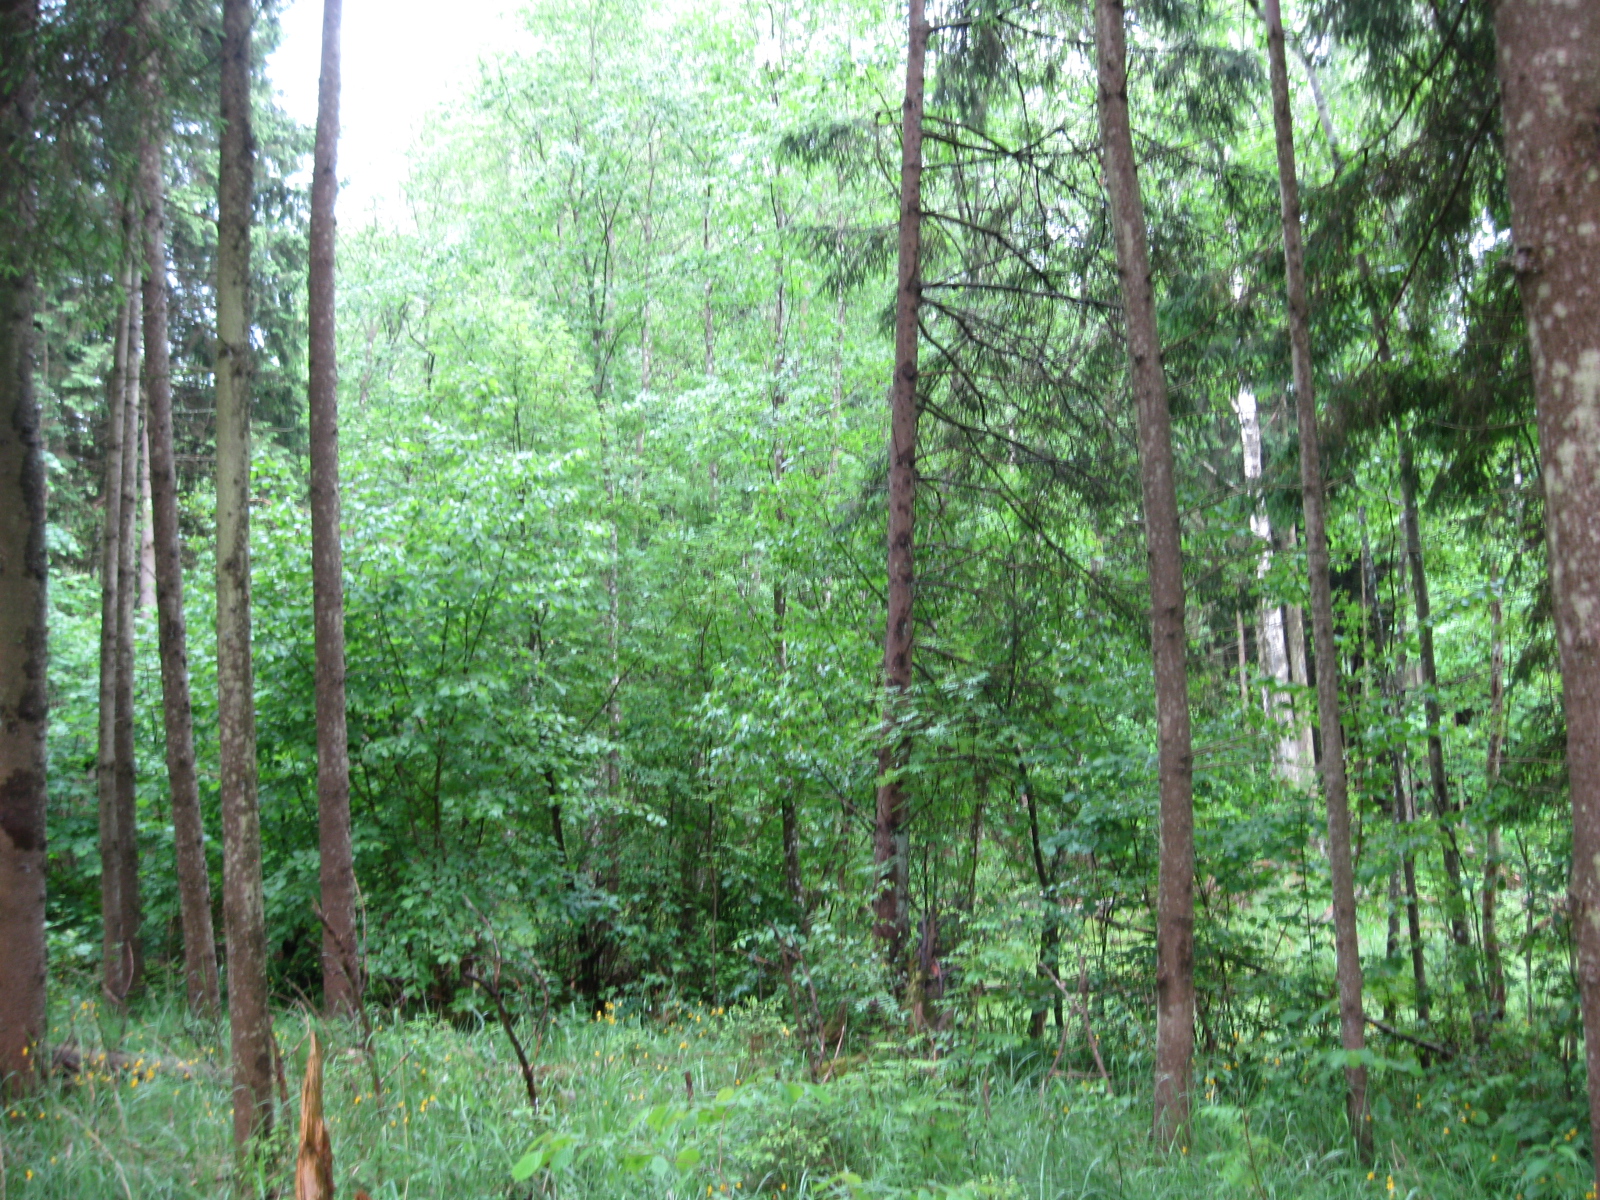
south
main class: Woodland
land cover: Spruce dominated mixed woodland
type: hemiboreal forest and nemoral coniferous forest and mixed broadleaved-coniferous forest
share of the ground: > 75 %
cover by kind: coniferous forest trees 50 %, broadleaved forest trees 30 %, herbaceous plants 20 %
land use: Forestry
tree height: > 5 m
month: June
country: LT
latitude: 55.4033
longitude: 23.7765
